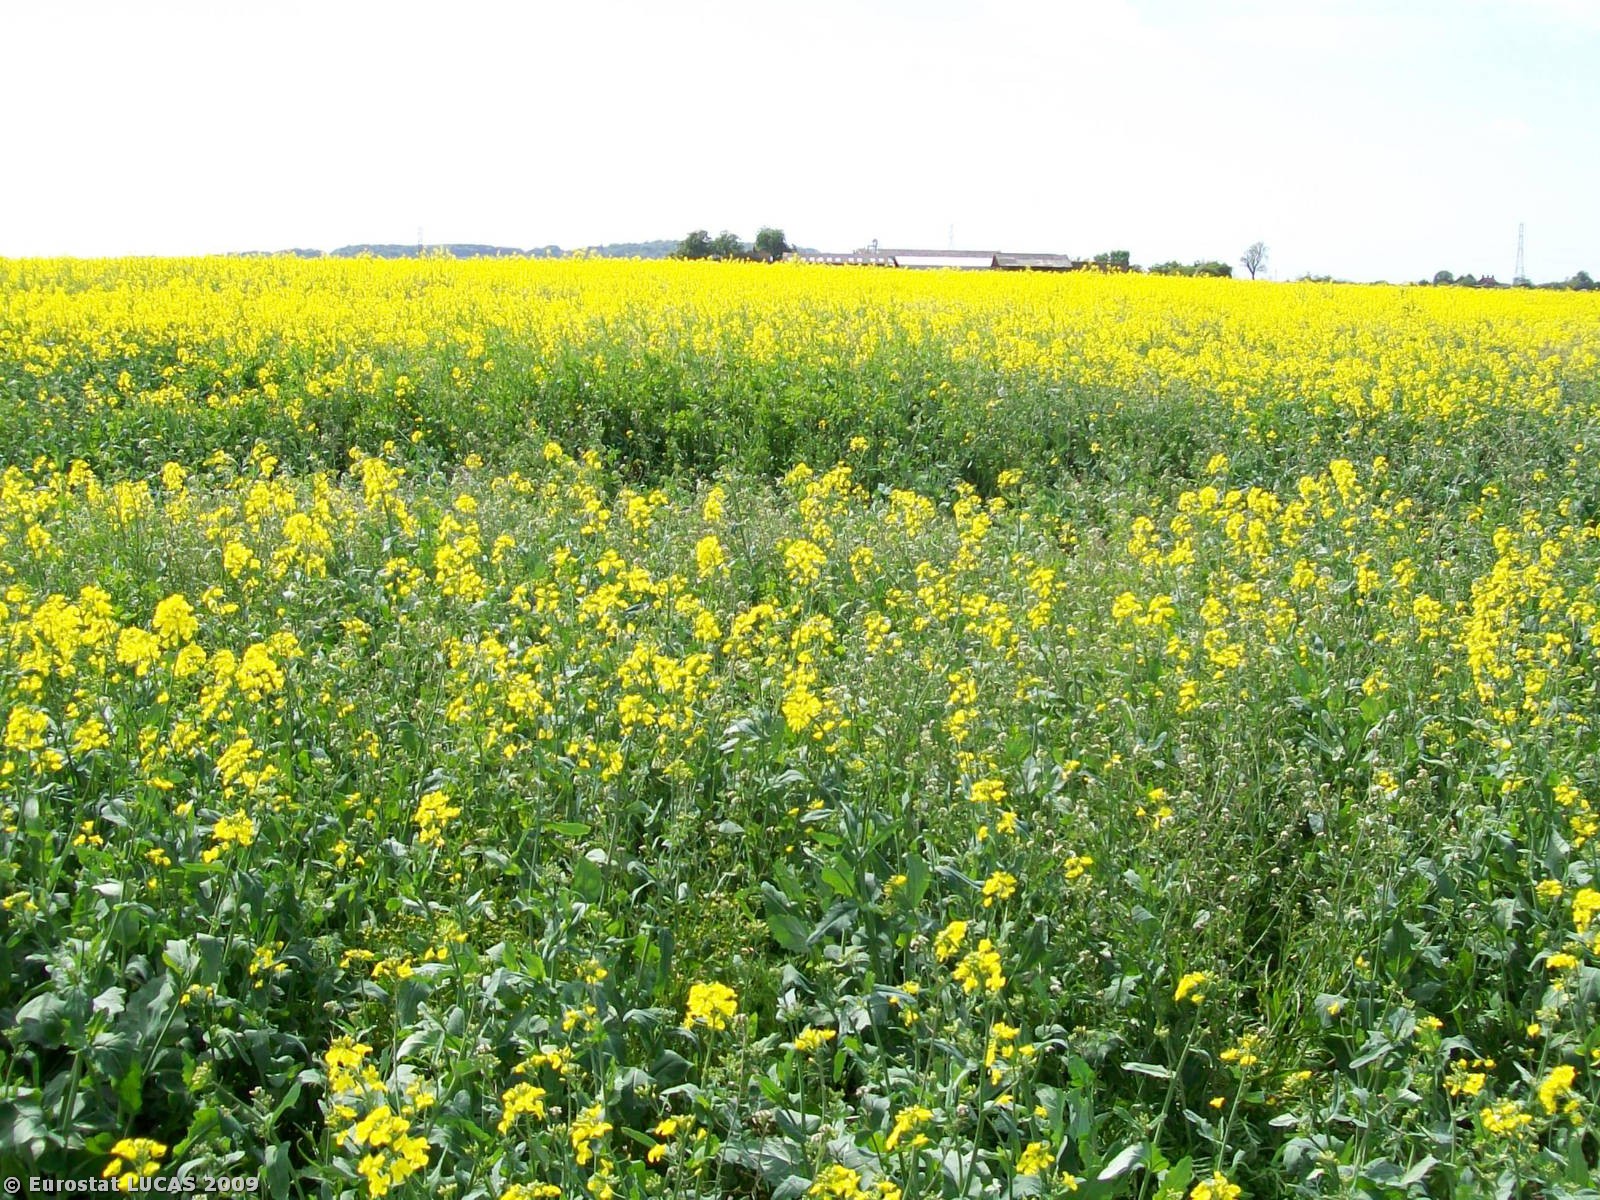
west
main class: Cropland
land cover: Rape and turnip rape
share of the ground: > 75 %
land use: Agriculture (excluding fallow land and kitchen gardens)
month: May
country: GB
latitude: 51.8595
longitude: -0.8603
